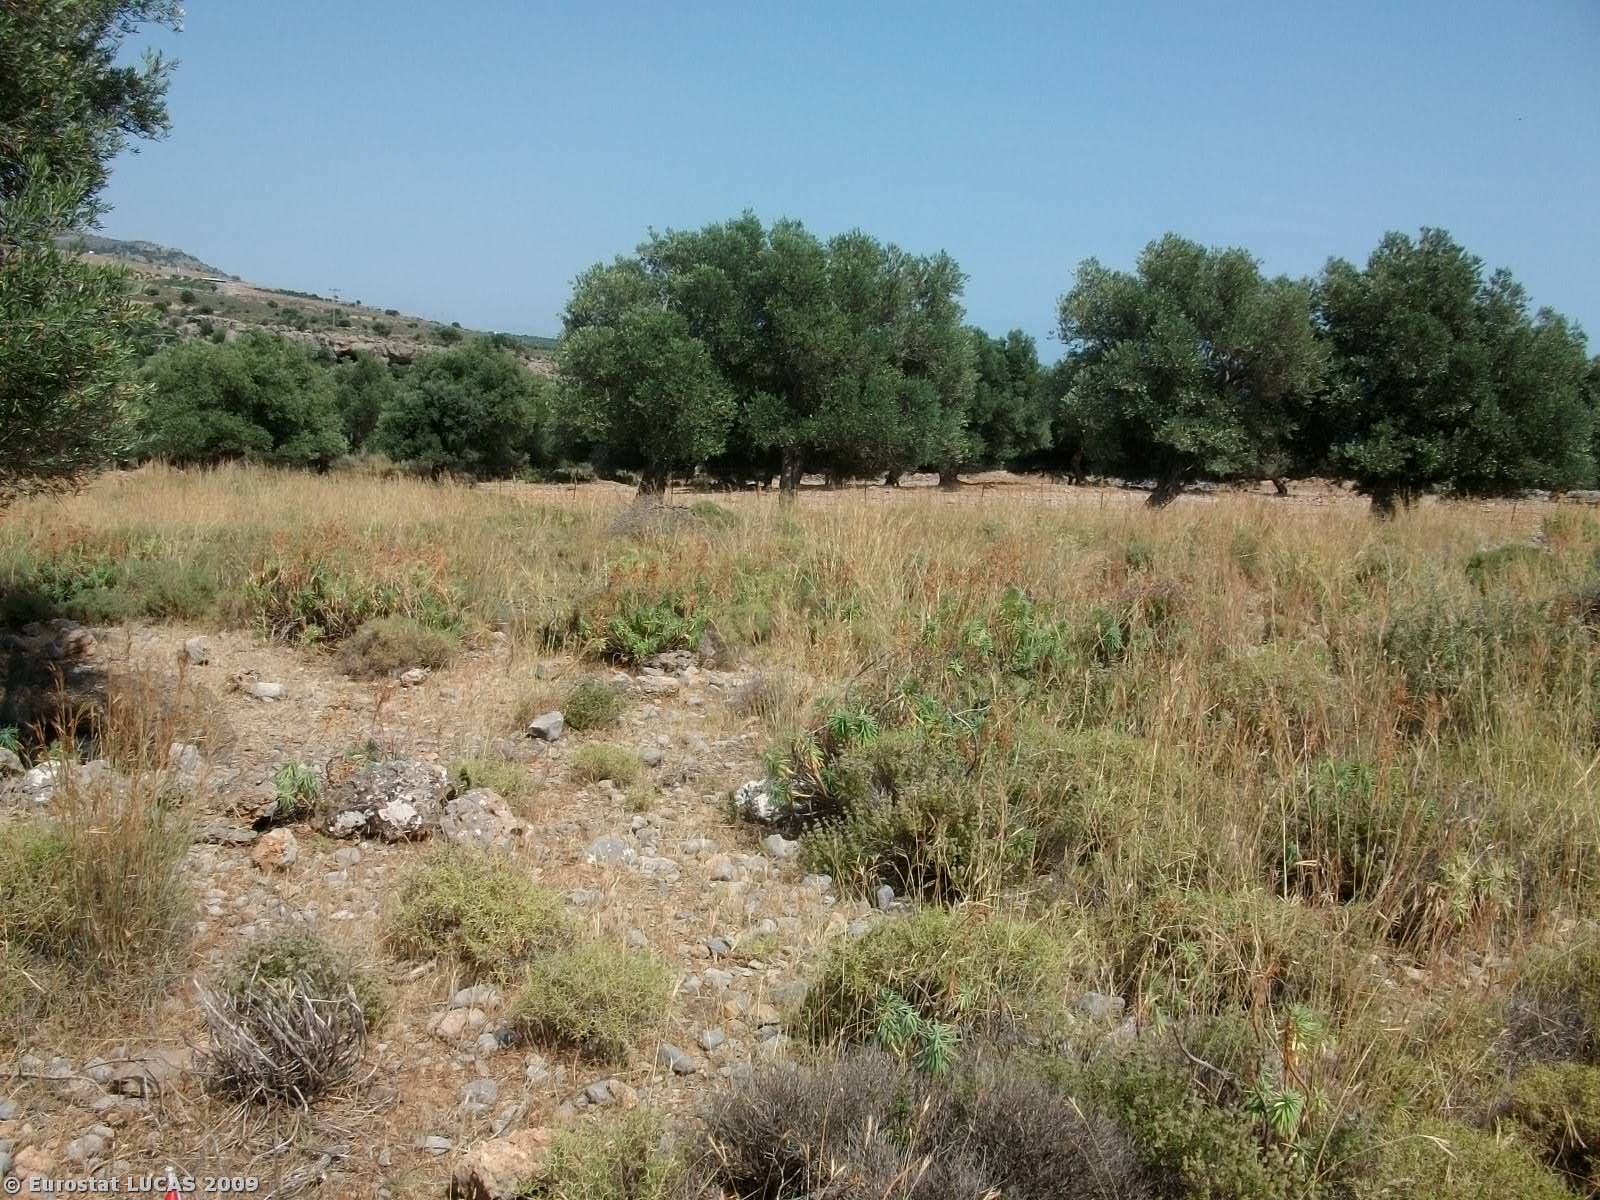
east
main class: Shrubland
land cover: Shrubland with sparse tree cover
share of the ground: > 75 %
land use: Agriculture (excluding fallow land and kitchen gardens)
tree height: < 5 m
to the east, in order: Shrubland with sparse tree cover; Shrubland without tree cover; Tracks; Olive groves; Tracks; Fences; Olive groves; Mixed woodland; Rivers and streams; Mixed woodland; Olive groves; Electric lines; Olive groves; Fences; Managed hedges; Olive groves; Bare land; Grass margins; Tracks; Shrubland with sparse tree cover
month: June
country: GR
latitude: 35.2065
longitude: 24.1844
